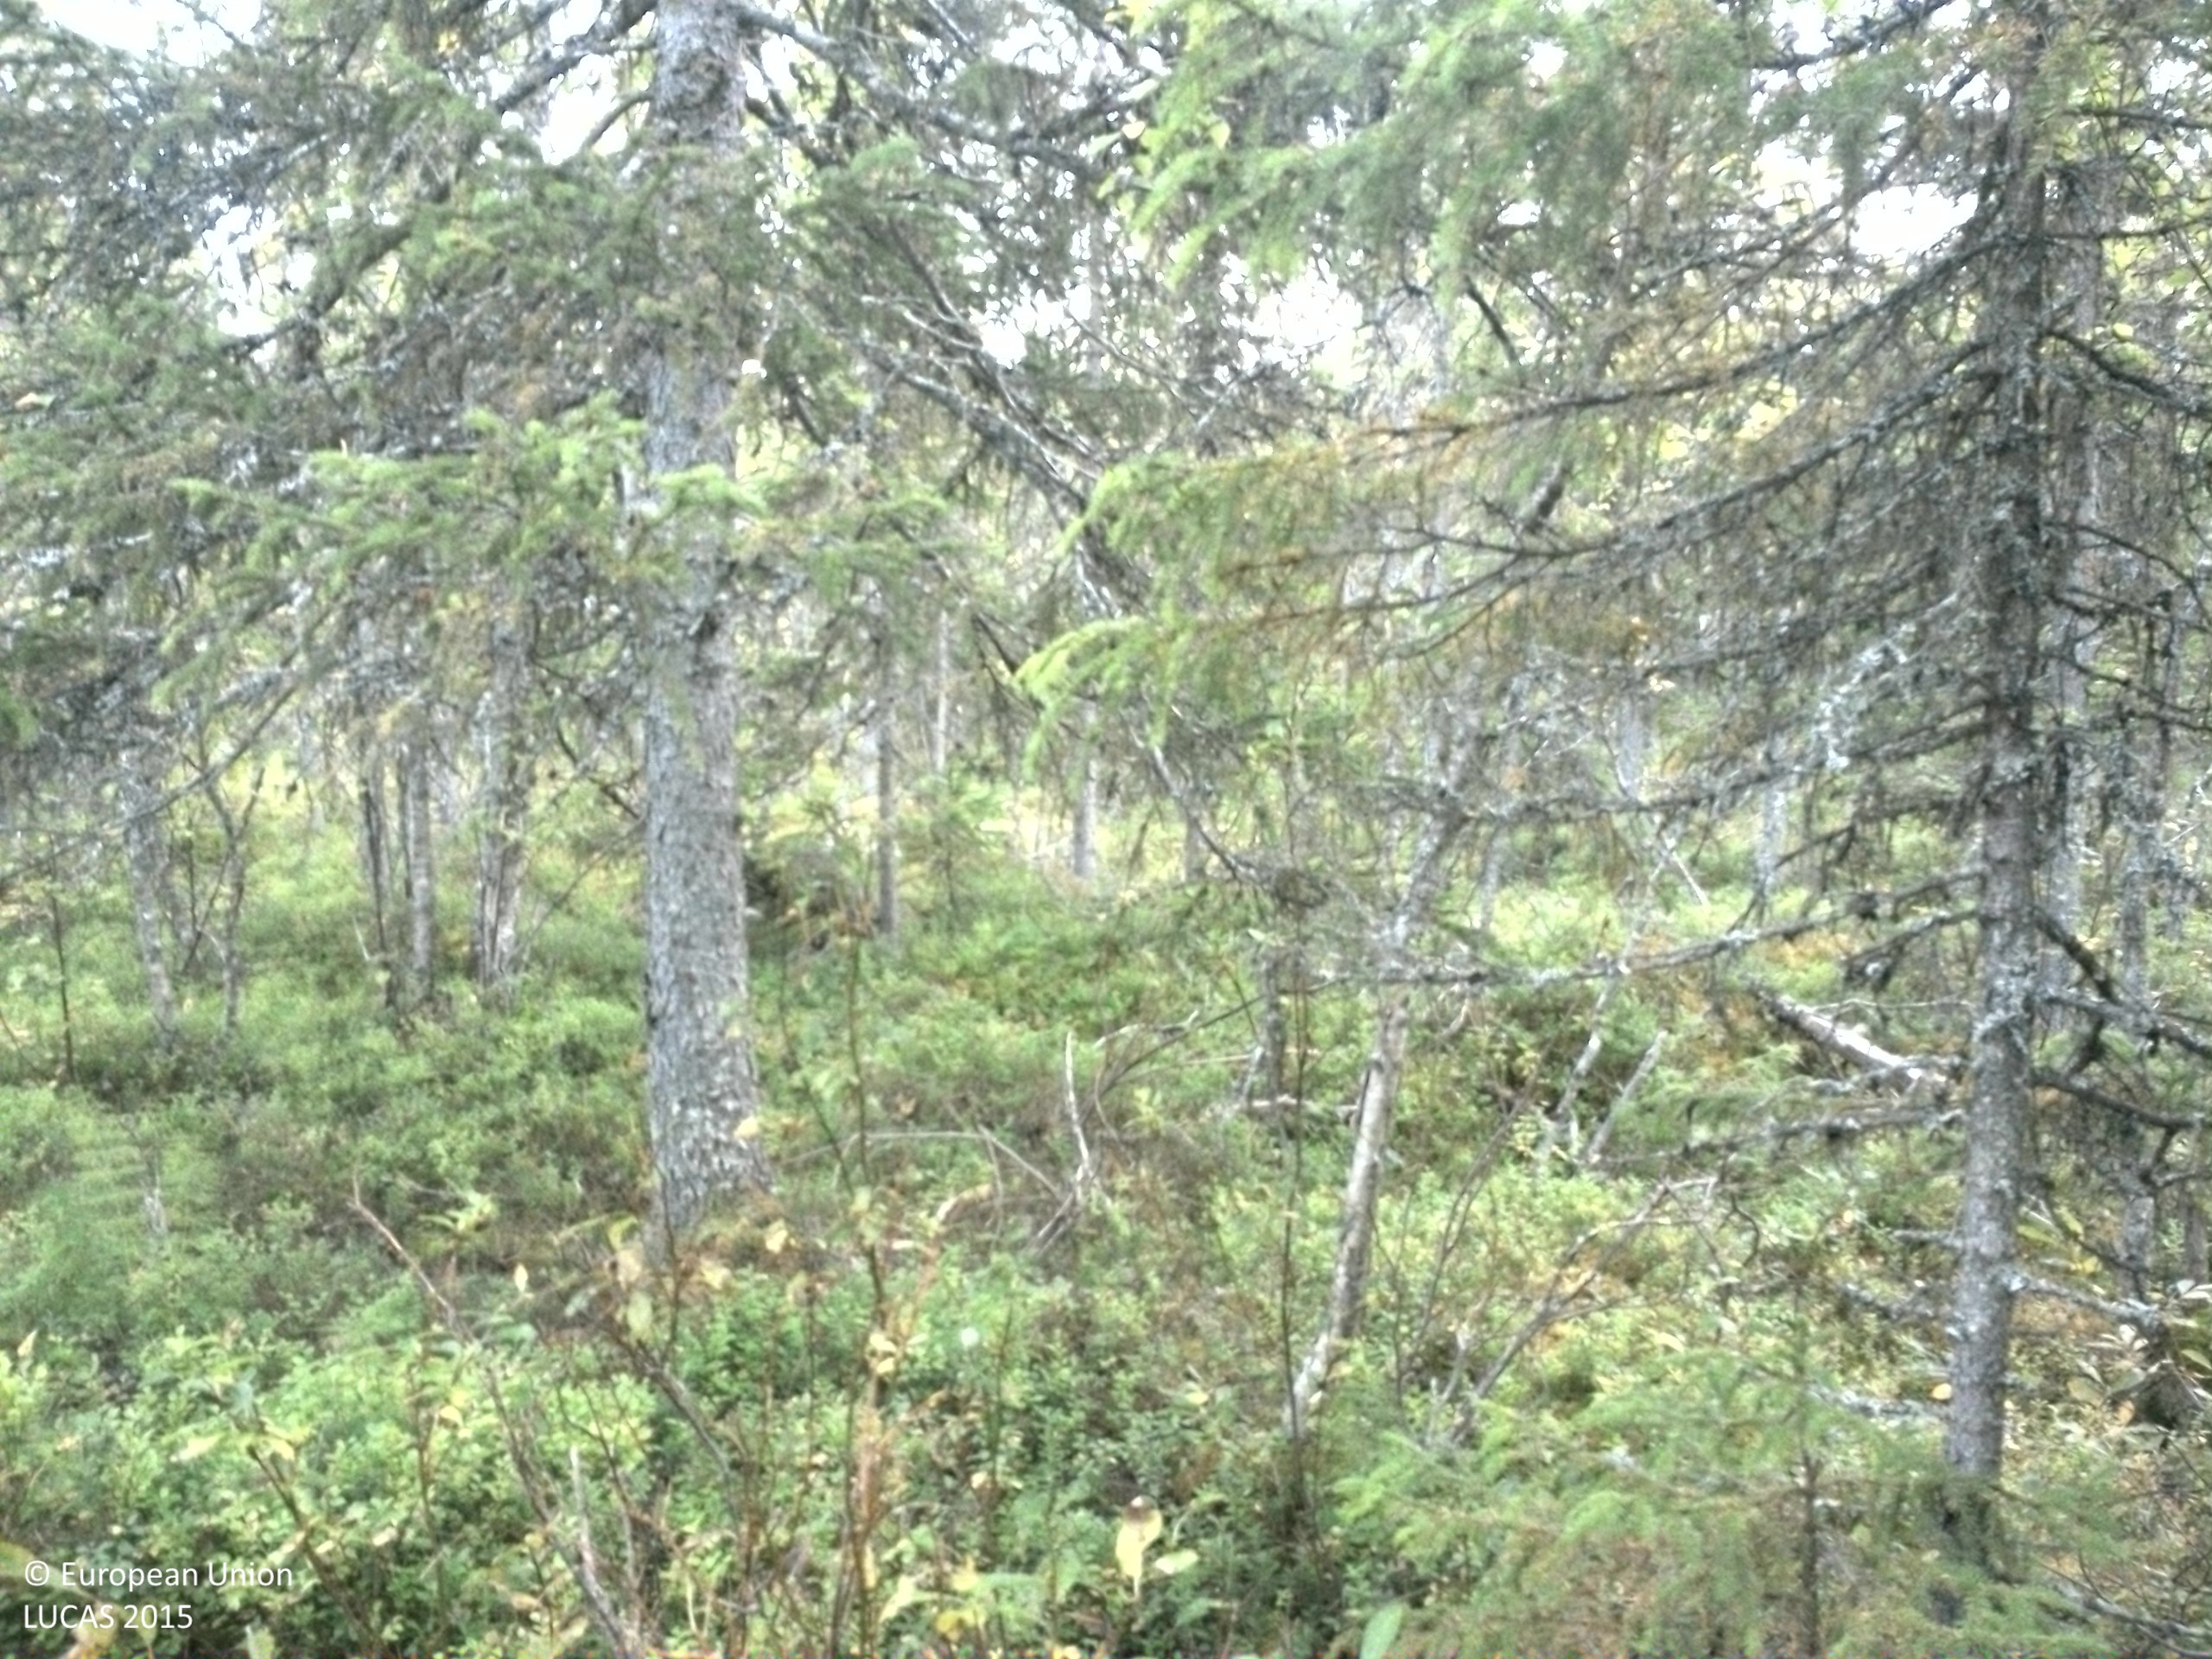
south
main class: Woodland
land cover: Other mixed woodland
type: boreal forest
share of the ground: 50 - 75 %
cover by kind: coniferous forest trees 45 %, shrubs 30 %, broadleaved forest trees 15 %, lichens and mosses 10 %
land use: Forestry
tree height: > 5 m
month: September
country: SE
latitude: 63.8953
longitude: 16.6730
